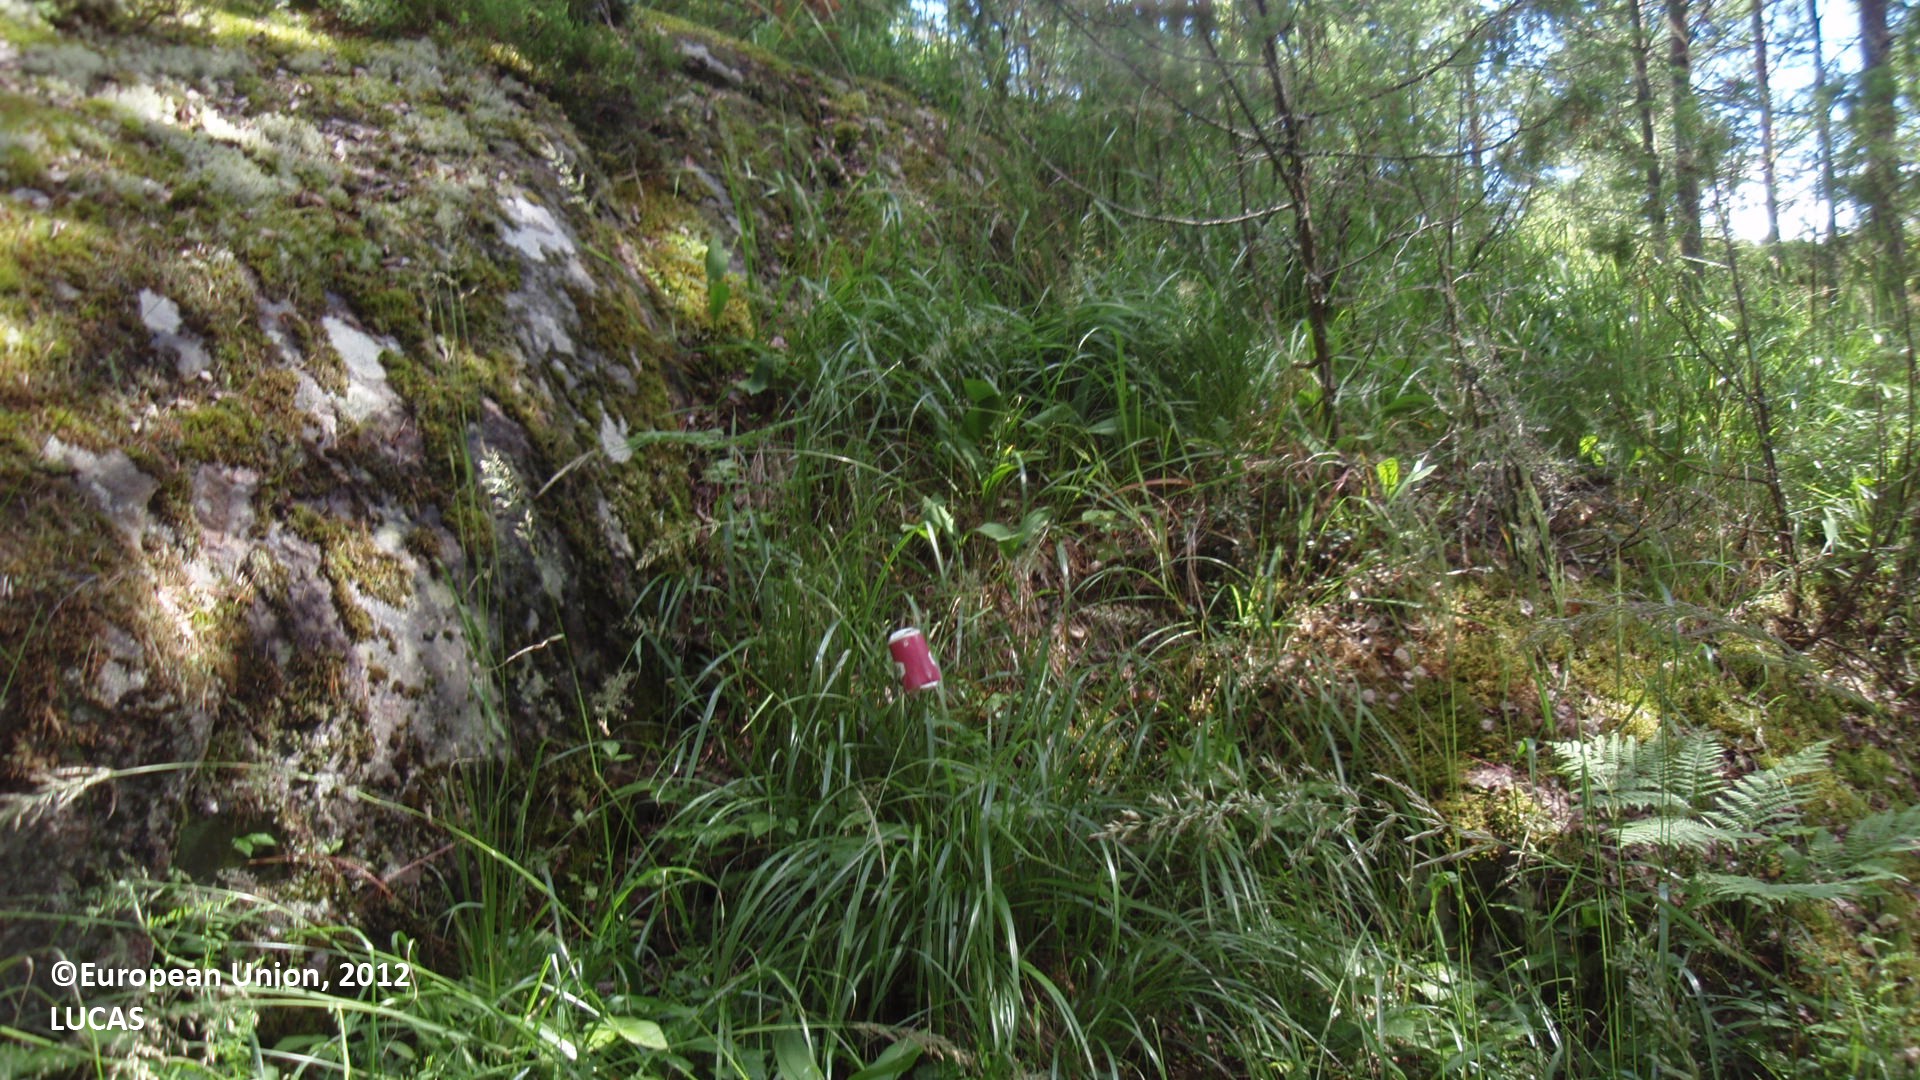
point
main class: Woodland
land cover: Pine dominated coniferous woodland
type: boreal forest
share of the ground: 50 - 75 %
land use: Forestry
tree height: > 5 m
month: July
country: FI
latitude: 61.5791
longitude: 28.4994
